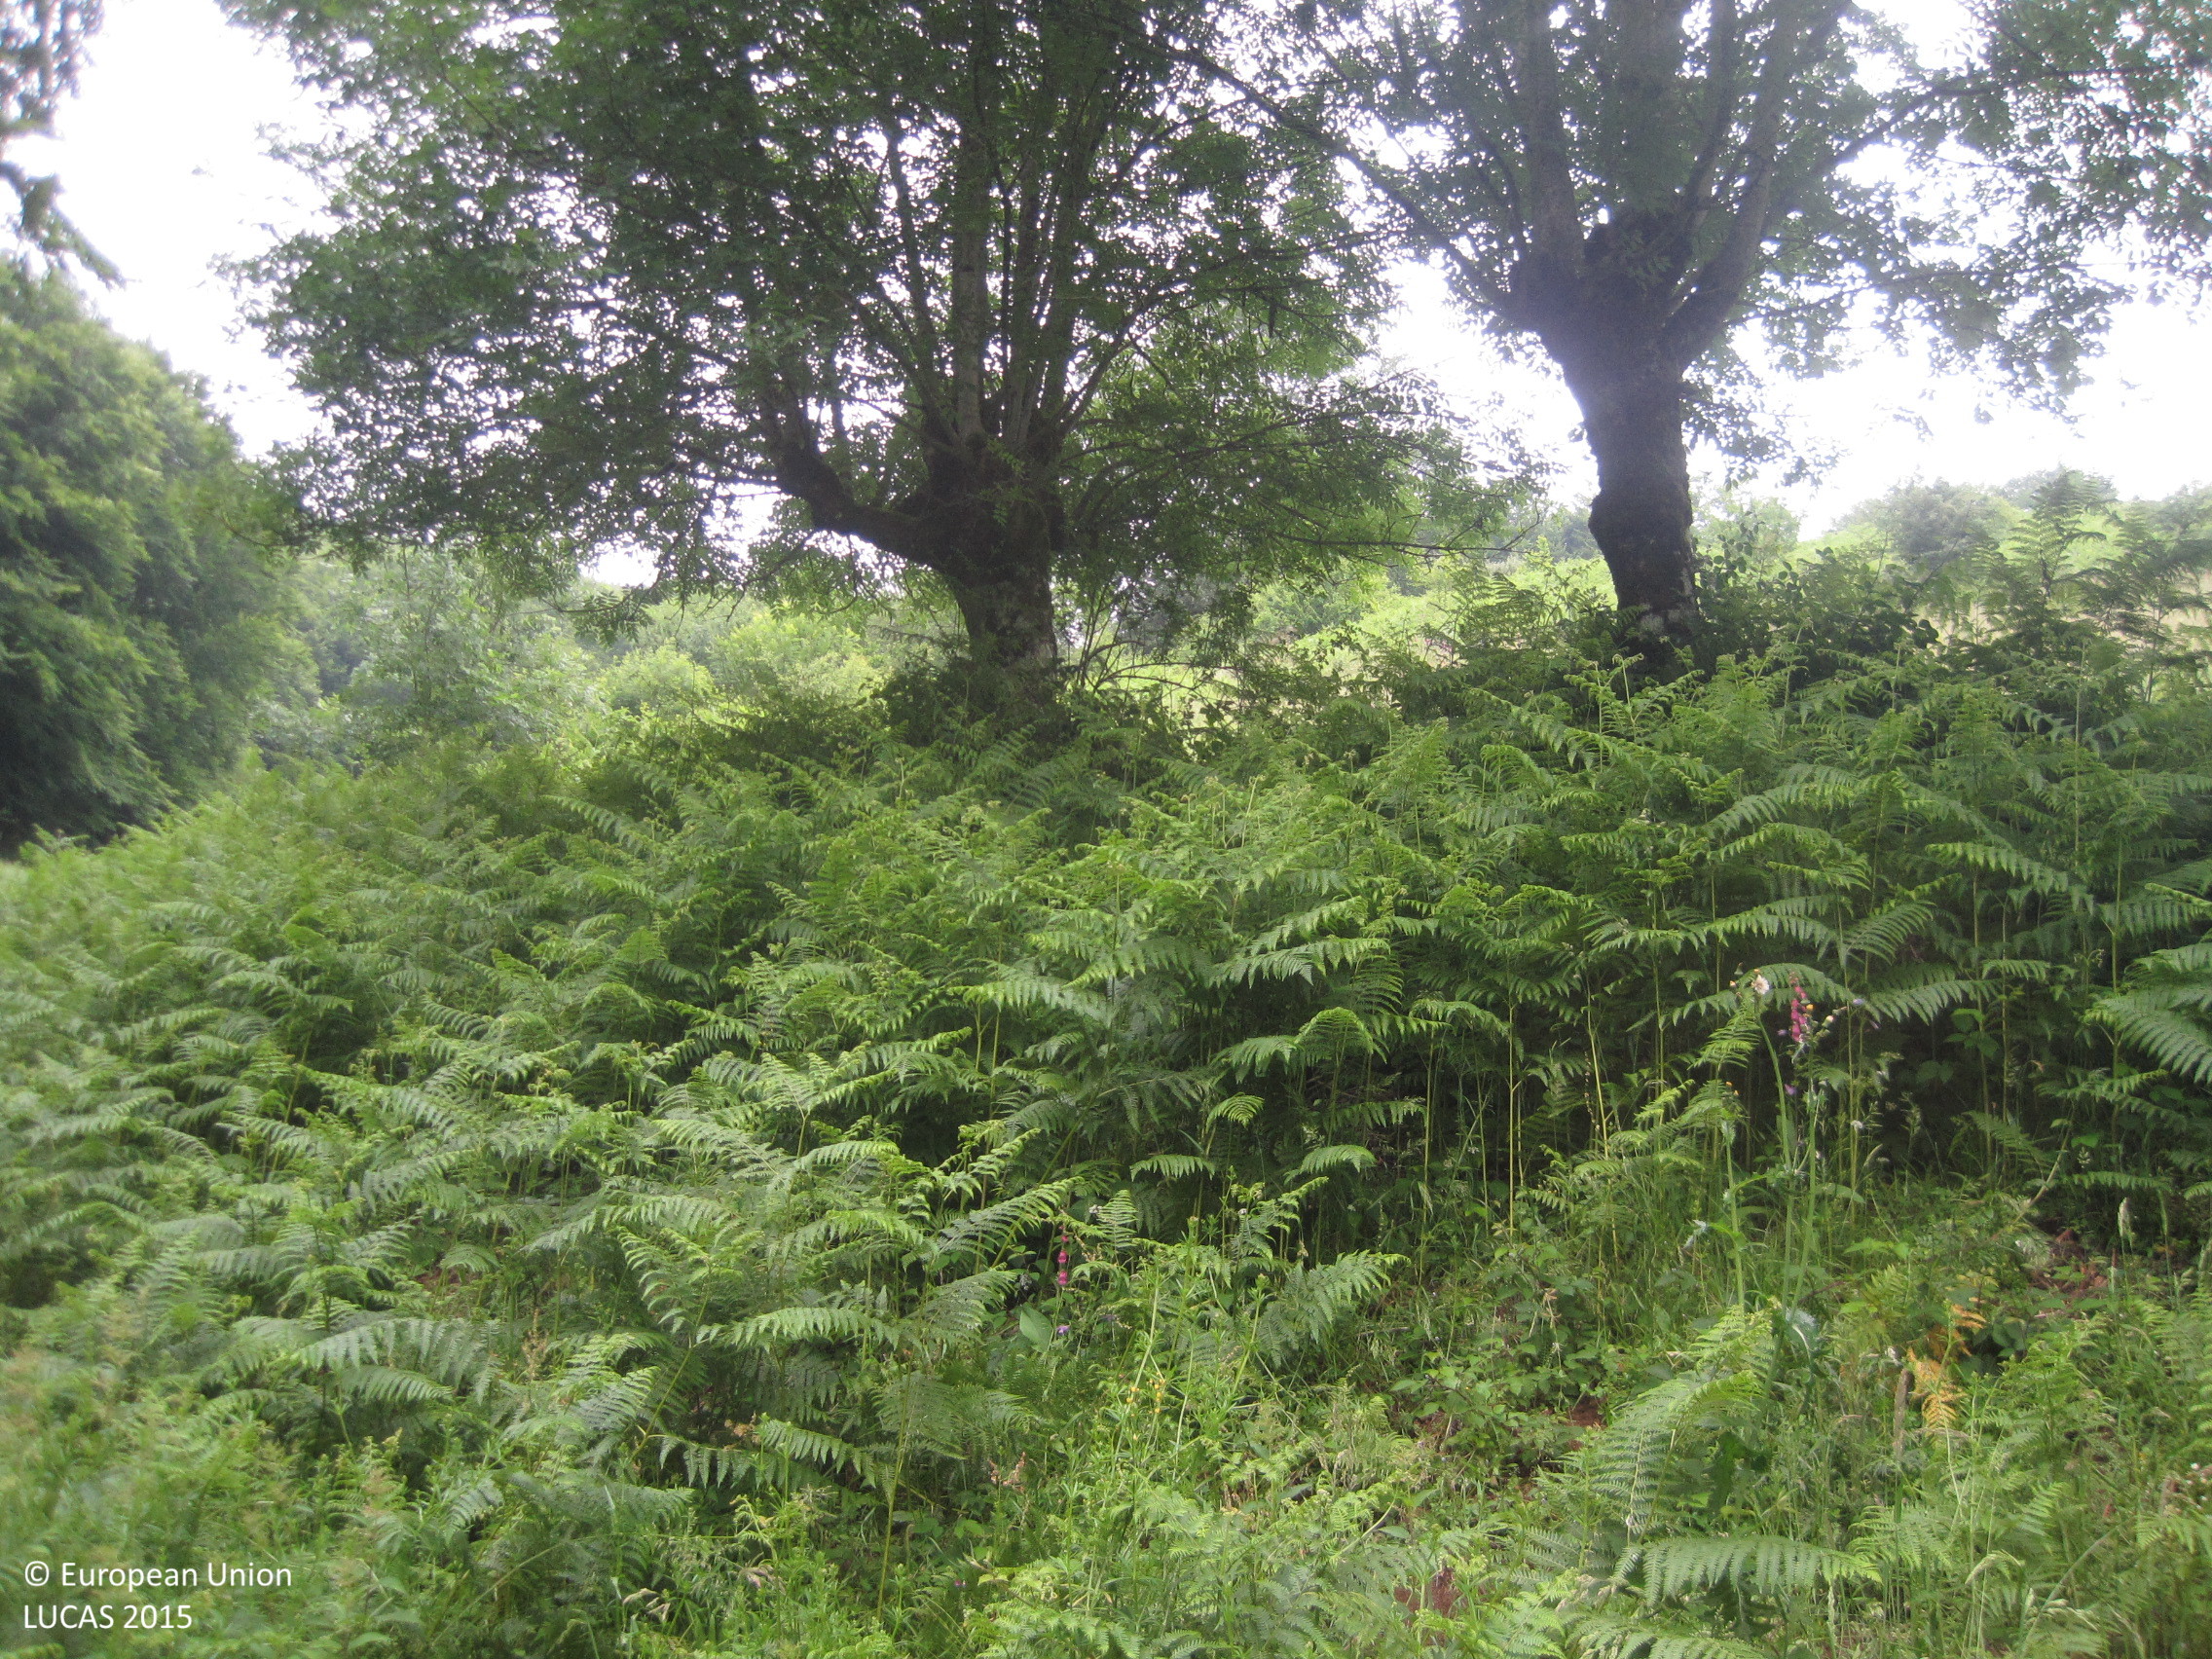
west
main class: Woodland
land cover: Broadleaved woodland
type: beech forest
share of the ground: 50 - 75 %
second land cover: Grassland without tree/shrub cover
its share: > 75 %
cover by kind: herbaceous plants 60 %, broadleaved forest trees 40 %
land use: Forestry
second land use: Agriculture (excluding fallow land and kitchen gardens)
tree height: > 5 m
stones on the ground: < 10 %
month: June
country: ES
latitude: 43.0356
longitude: -1.8134
